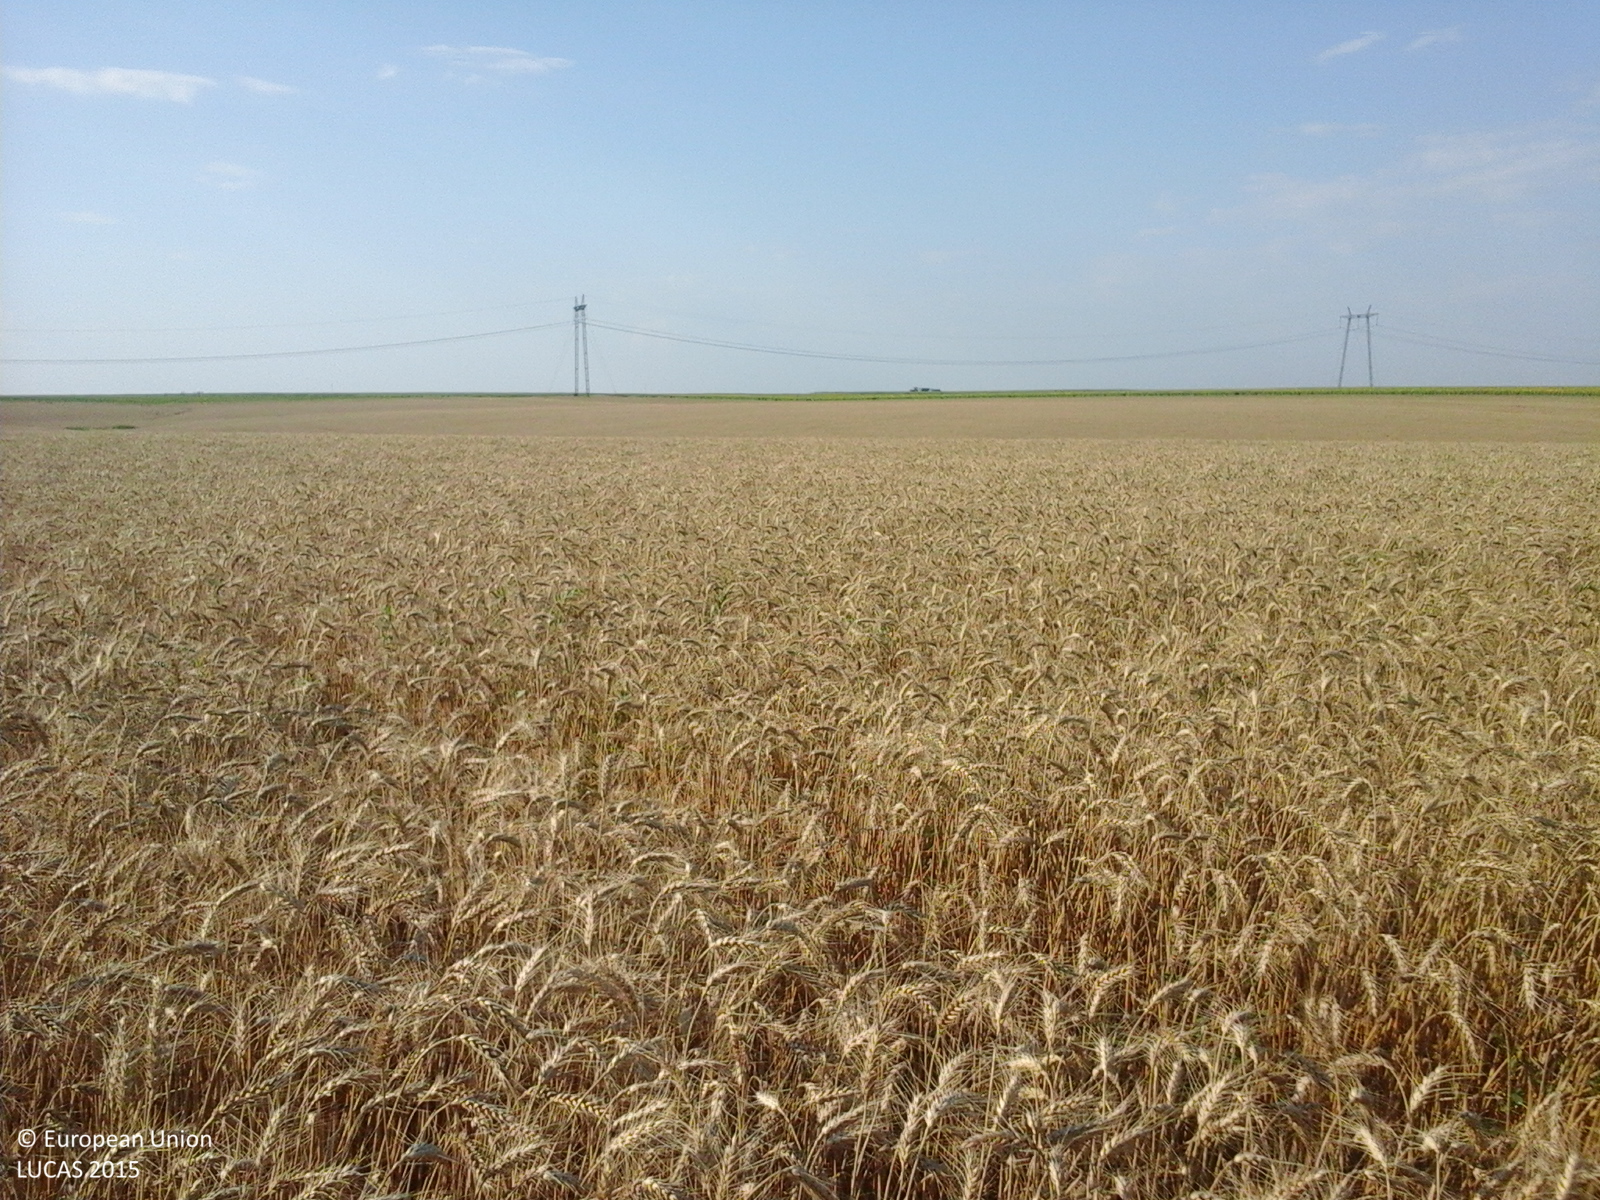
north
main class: Cropland
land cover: Common wheat
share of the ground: > 75 %
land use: Agriculture (excluding fallow land and kitchen gardens)
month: July
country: RO
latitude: 44.3107
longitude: 24.6522
